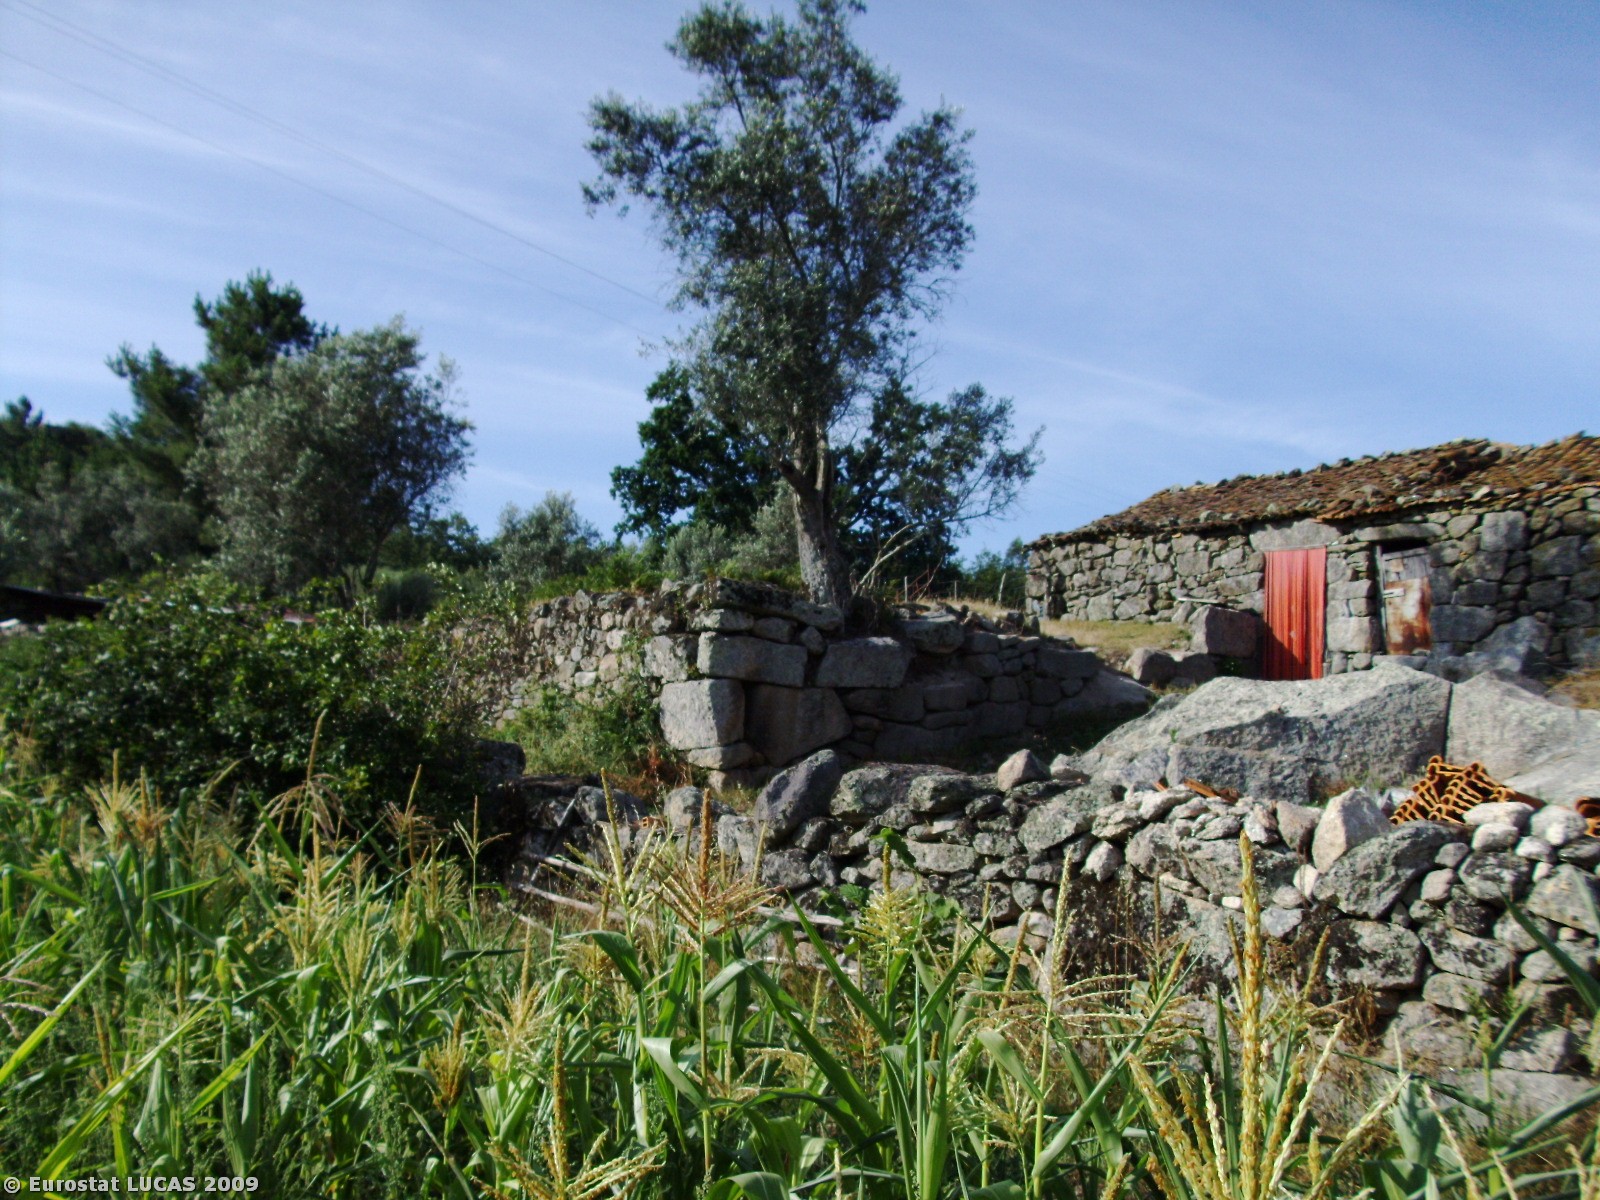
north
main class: Cropland
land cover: Olive groves
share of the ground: 10 - 25 %
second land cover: Maize
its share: > 75 %
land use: Agriculture (excluding fallow land and kitchen gardens)
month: July
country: PT
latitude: 40.5799
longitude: -7.6114
